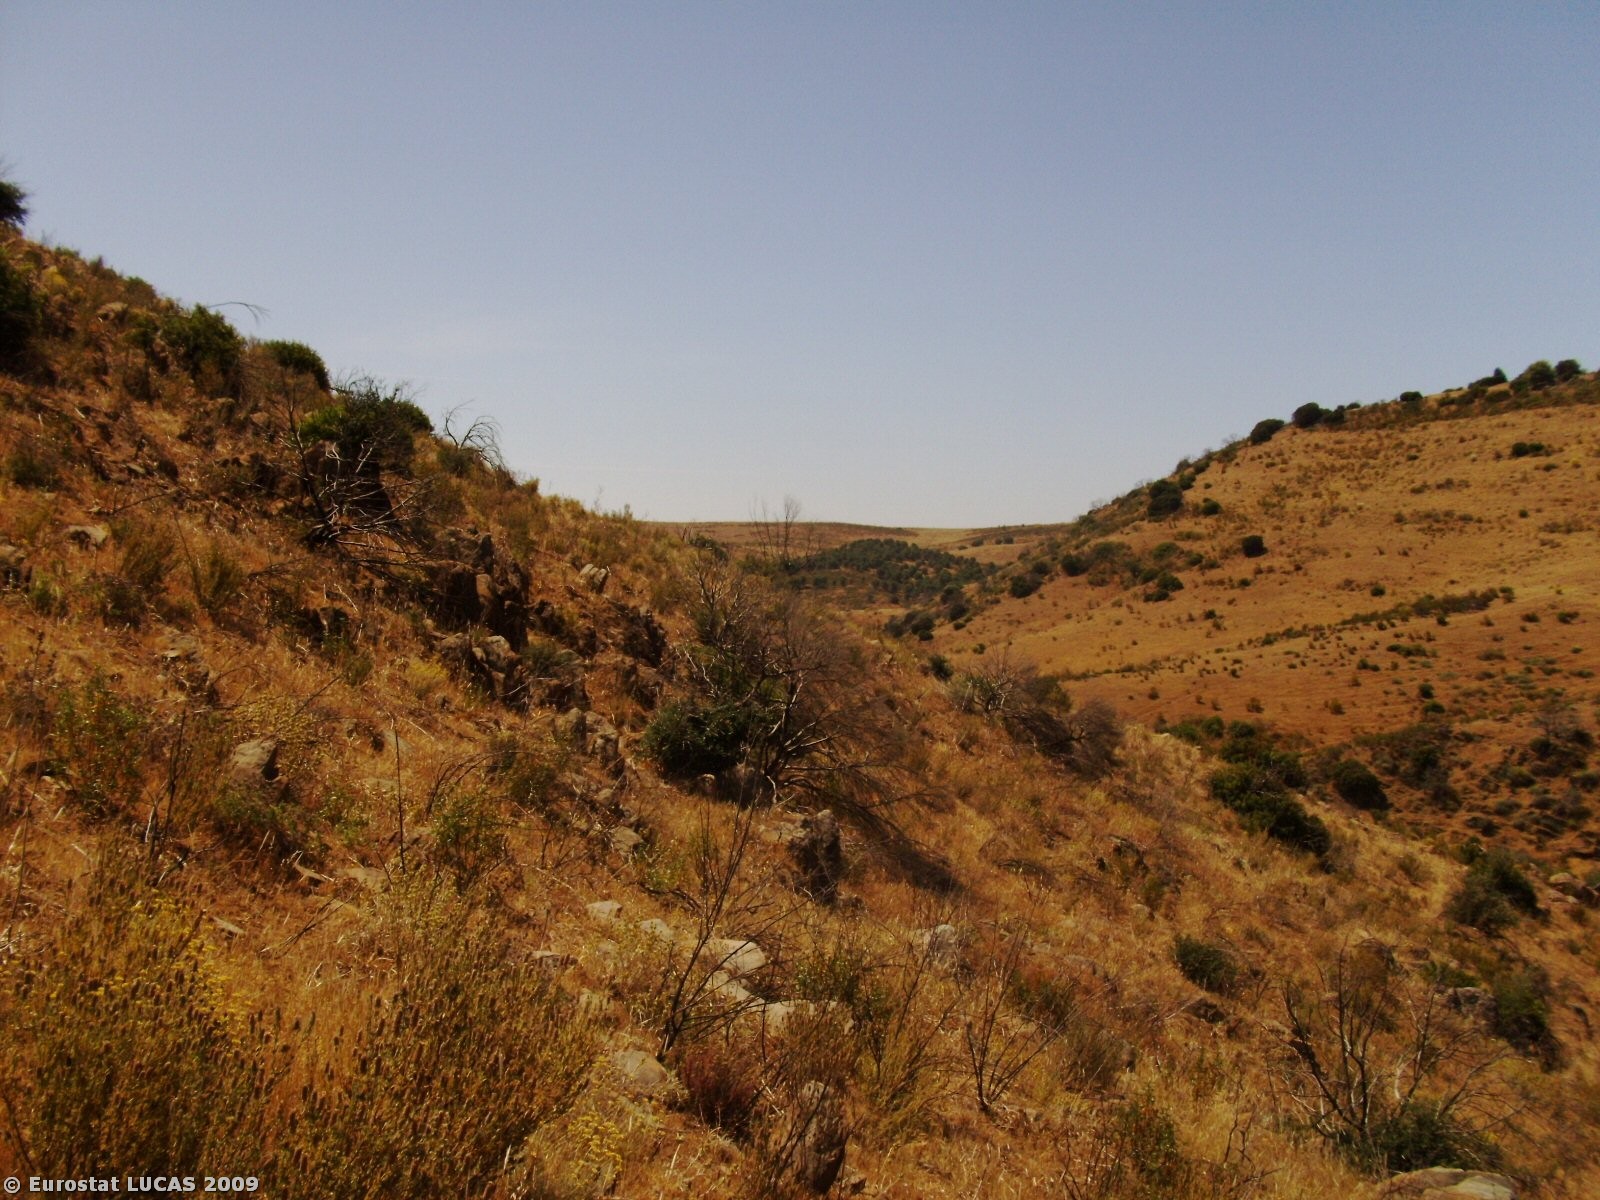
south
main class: Shrubland
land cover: Shrubland without tree cover
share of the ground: 50 - 75 %
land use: Agriculture (excluding fallow land and kitchen gardens)
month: May
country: PT
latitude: 37.6129
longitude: -7.6767
